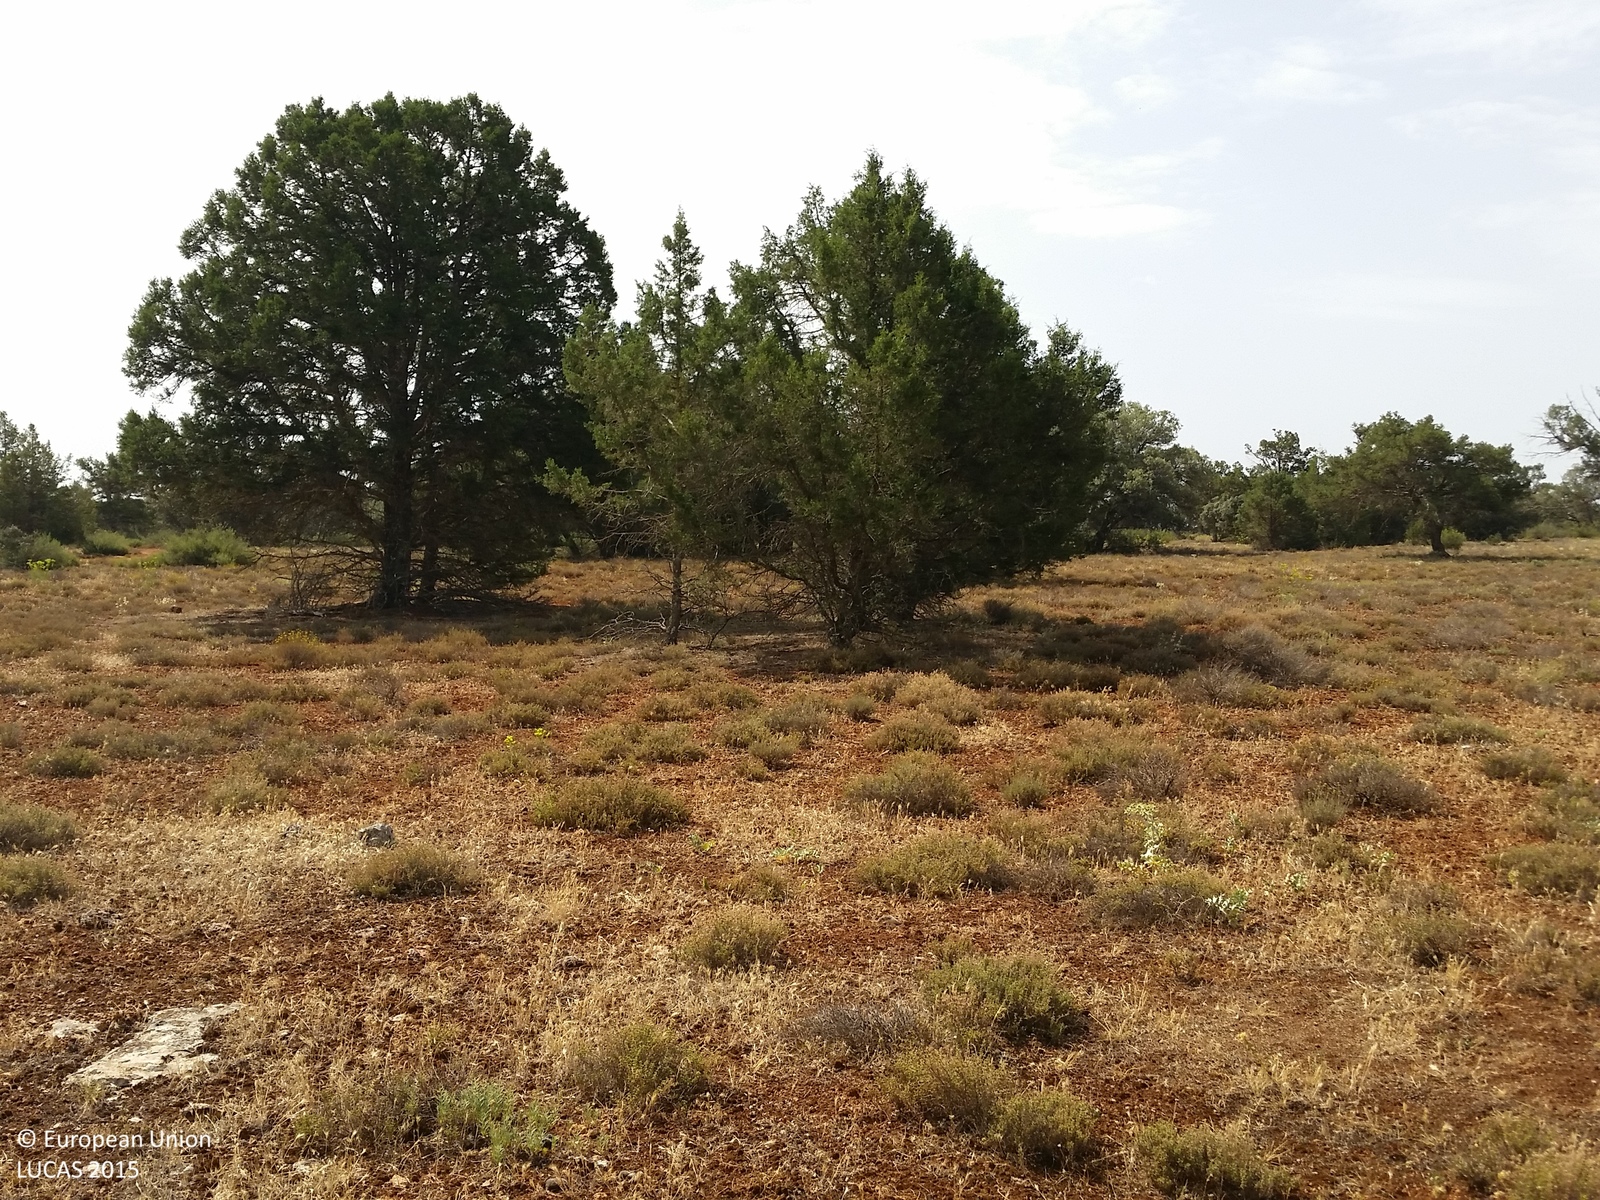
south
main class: Woodland
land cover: Pine dominated coniferous woodland
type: coniferous forest of the mediterranean region
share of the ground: > 75 %
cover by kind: coniferous forest trees 50 %, shrubs 20 %, herbaceous plants 15 %, consolidated bare surface 15 %
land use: Semi-natural and natural areas not in use
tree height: > 5 m
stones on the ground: 10 - 25 %
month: July
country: ES
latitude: 38.8925
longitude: -2.6765
